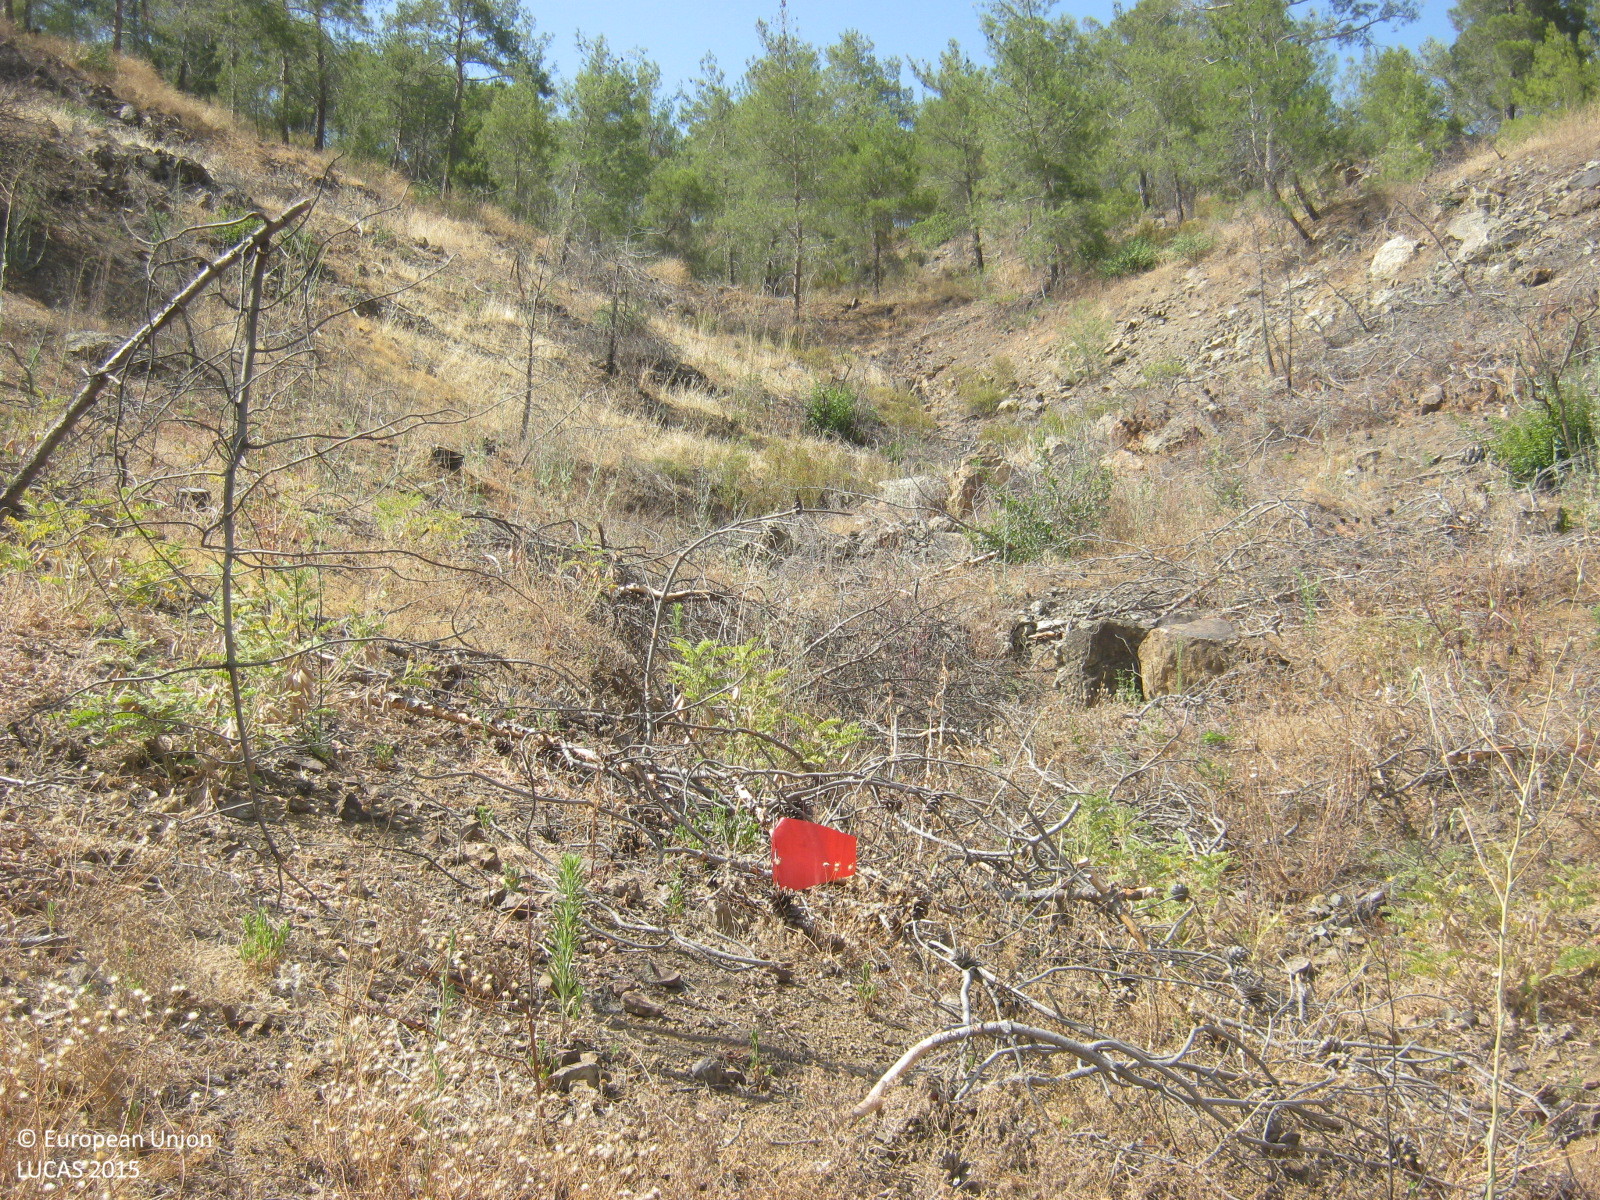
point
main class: Grassland
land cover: Grassland without tree/shrub cover
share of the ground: 10 - 25 %
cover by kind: unconsolidated bare surface 80 %, herbaceous plants 15 %, shrubs 5 %
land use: Forestry
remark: Burnt area
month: June
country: CY
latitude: 34.9806
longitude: 33.1500
